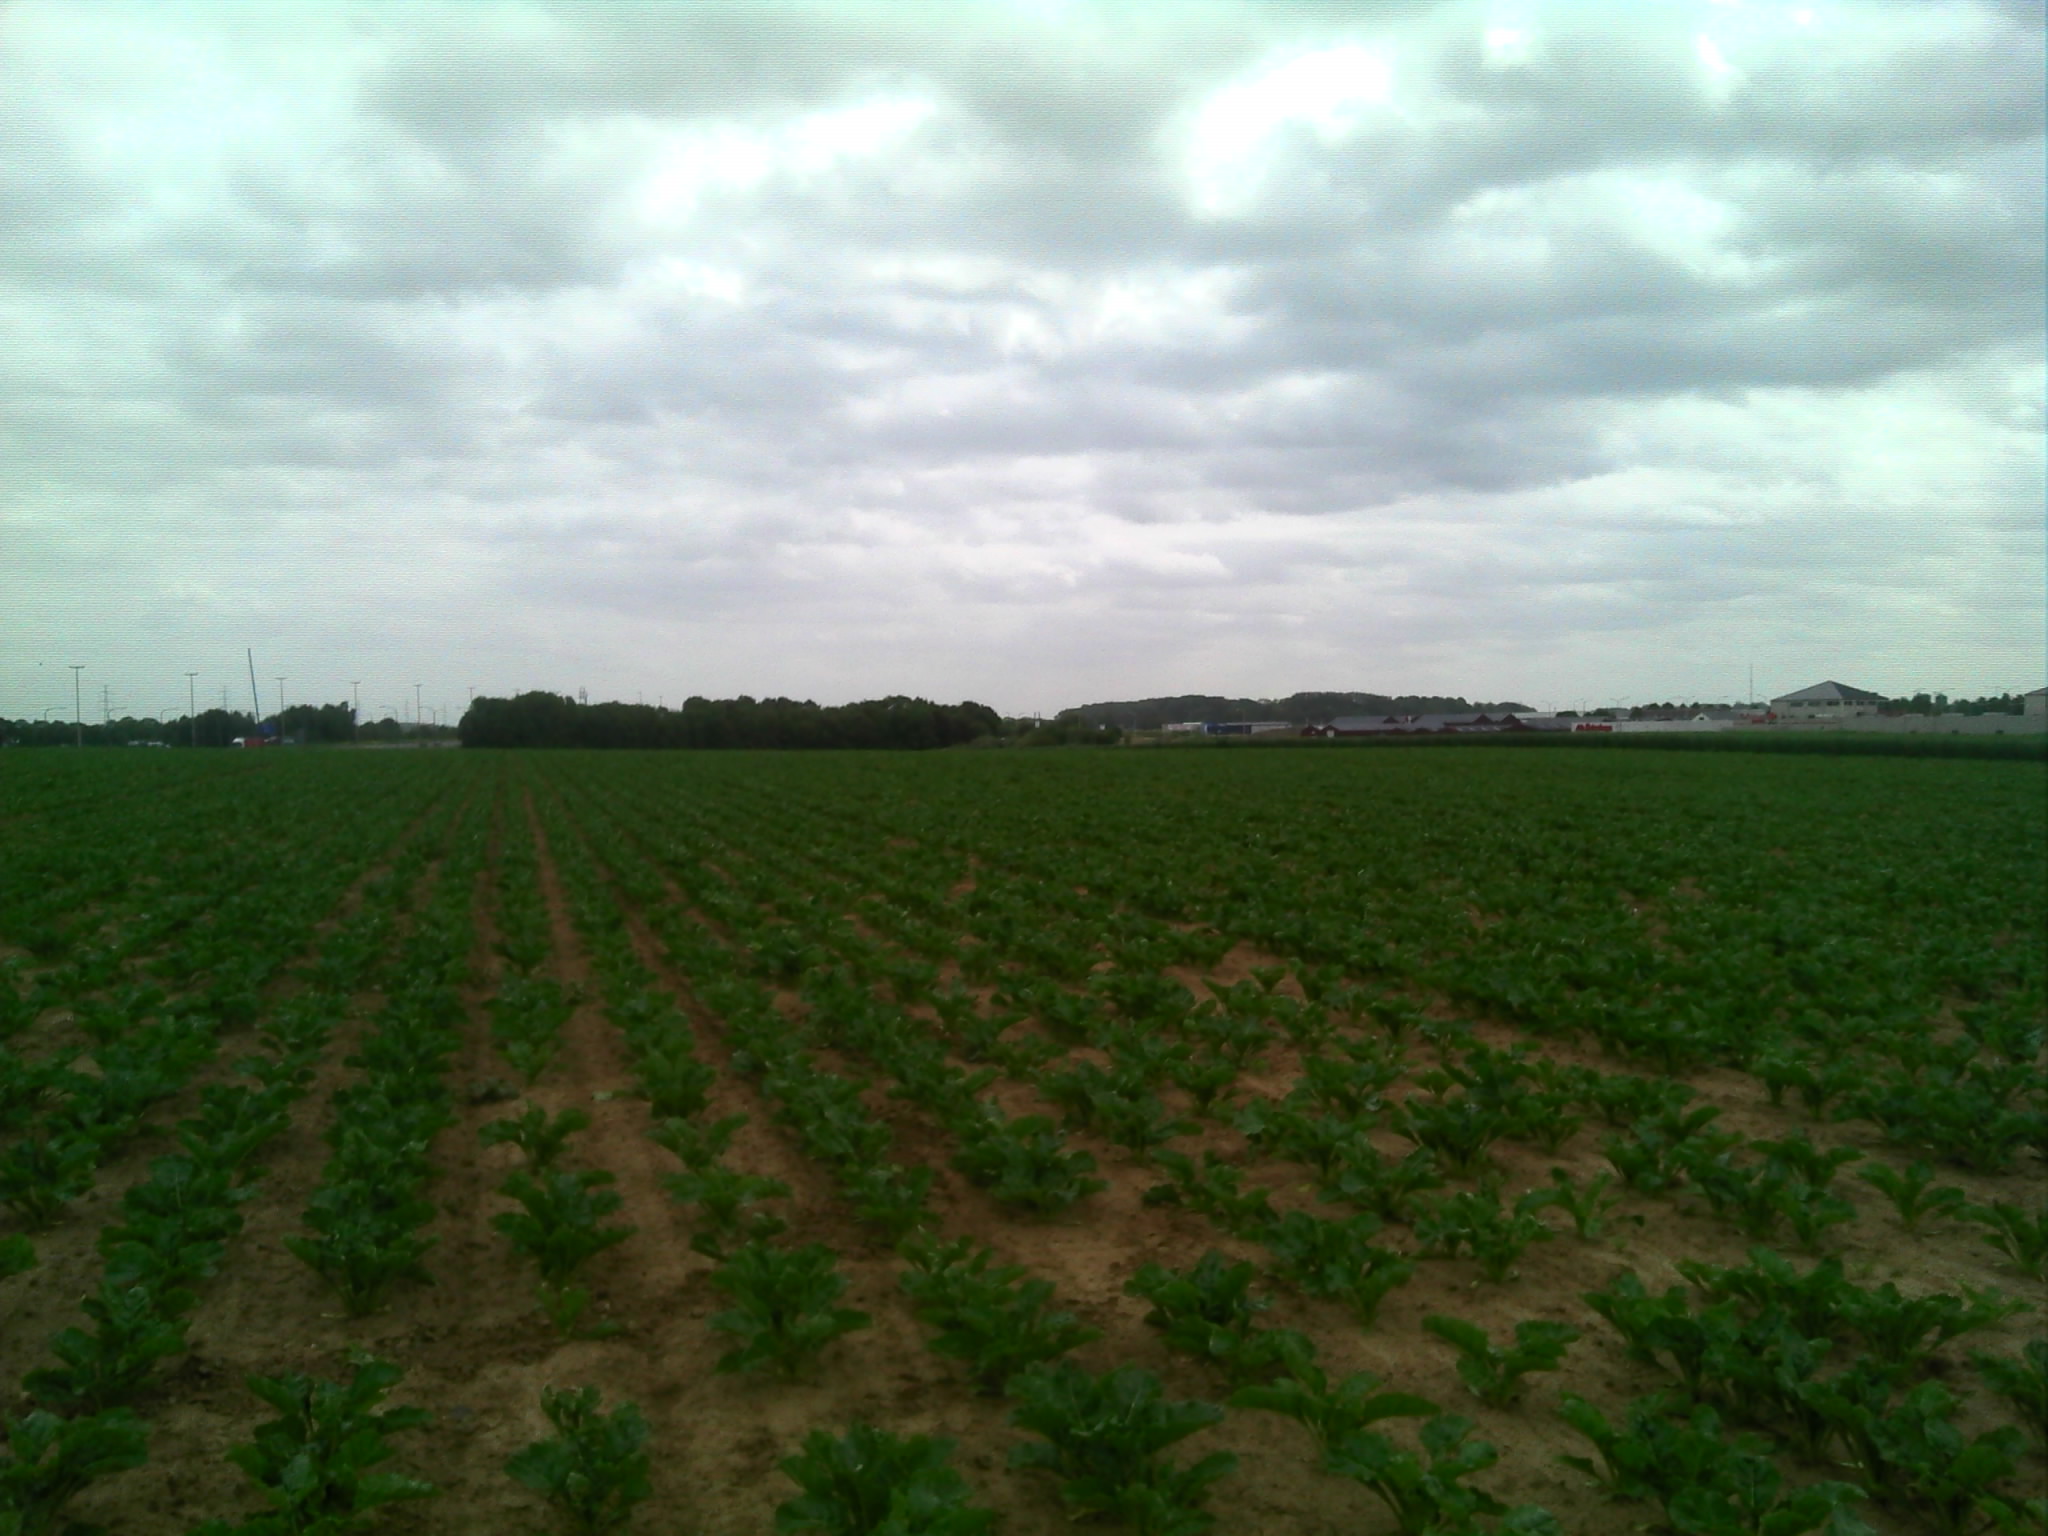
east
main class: Cropland
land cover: Sugar beet
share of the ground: 25 - 50 %
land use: Agriculture (excluding fallow land and kitchen gardens)
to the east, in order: Sugar beet; Common wheat
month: June
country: BE
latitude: 50.4940
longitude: 4.7102
